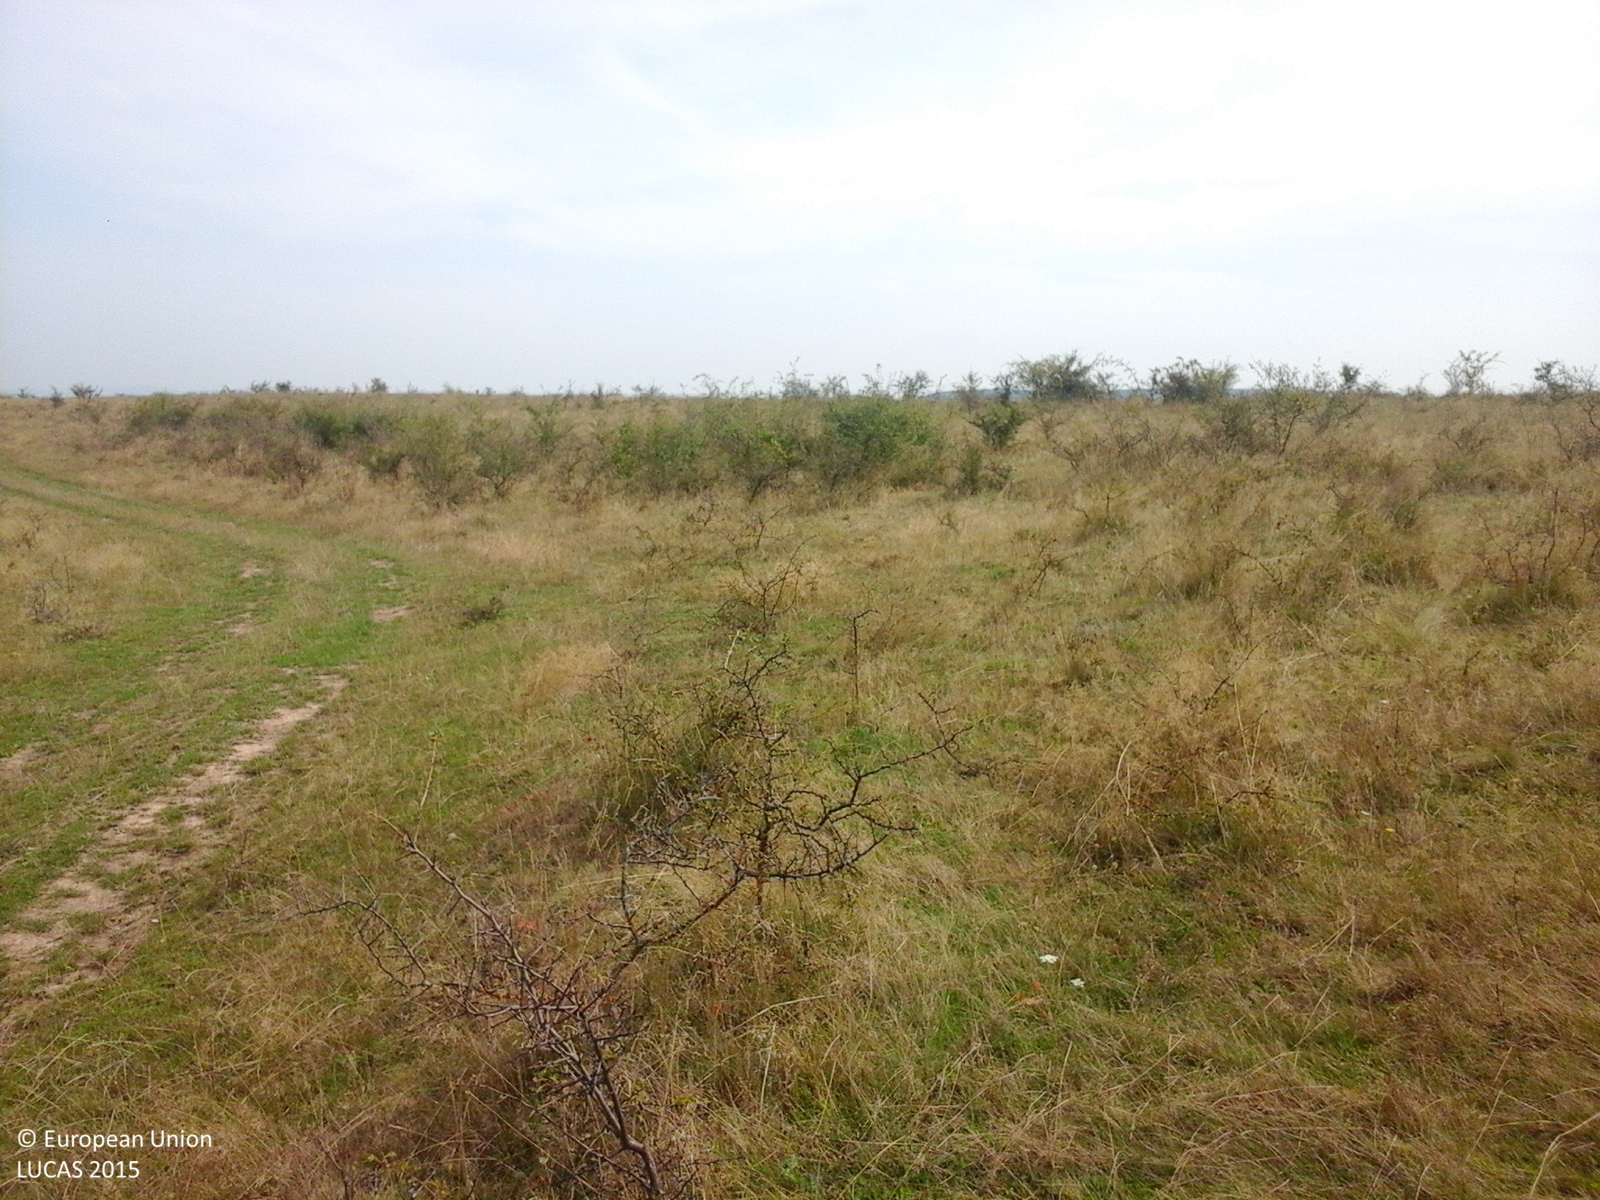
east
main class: Grassland
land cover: Grassland with sparse tree/shrub cover
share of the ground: > 75 %
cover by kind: herbaceous plants 85 %, shrubs 10 %, broadleaved forest trees 5 %
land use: Fallow land
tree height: < 5 m
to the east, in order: Grassland with sparse tree/shrub cover; Tracks; Grassland with sparse tree/shrub cover; Tracks; Grassland with sparse tree/shrub cover
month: September
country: RO
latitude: 47.1589
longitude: 23.7278
